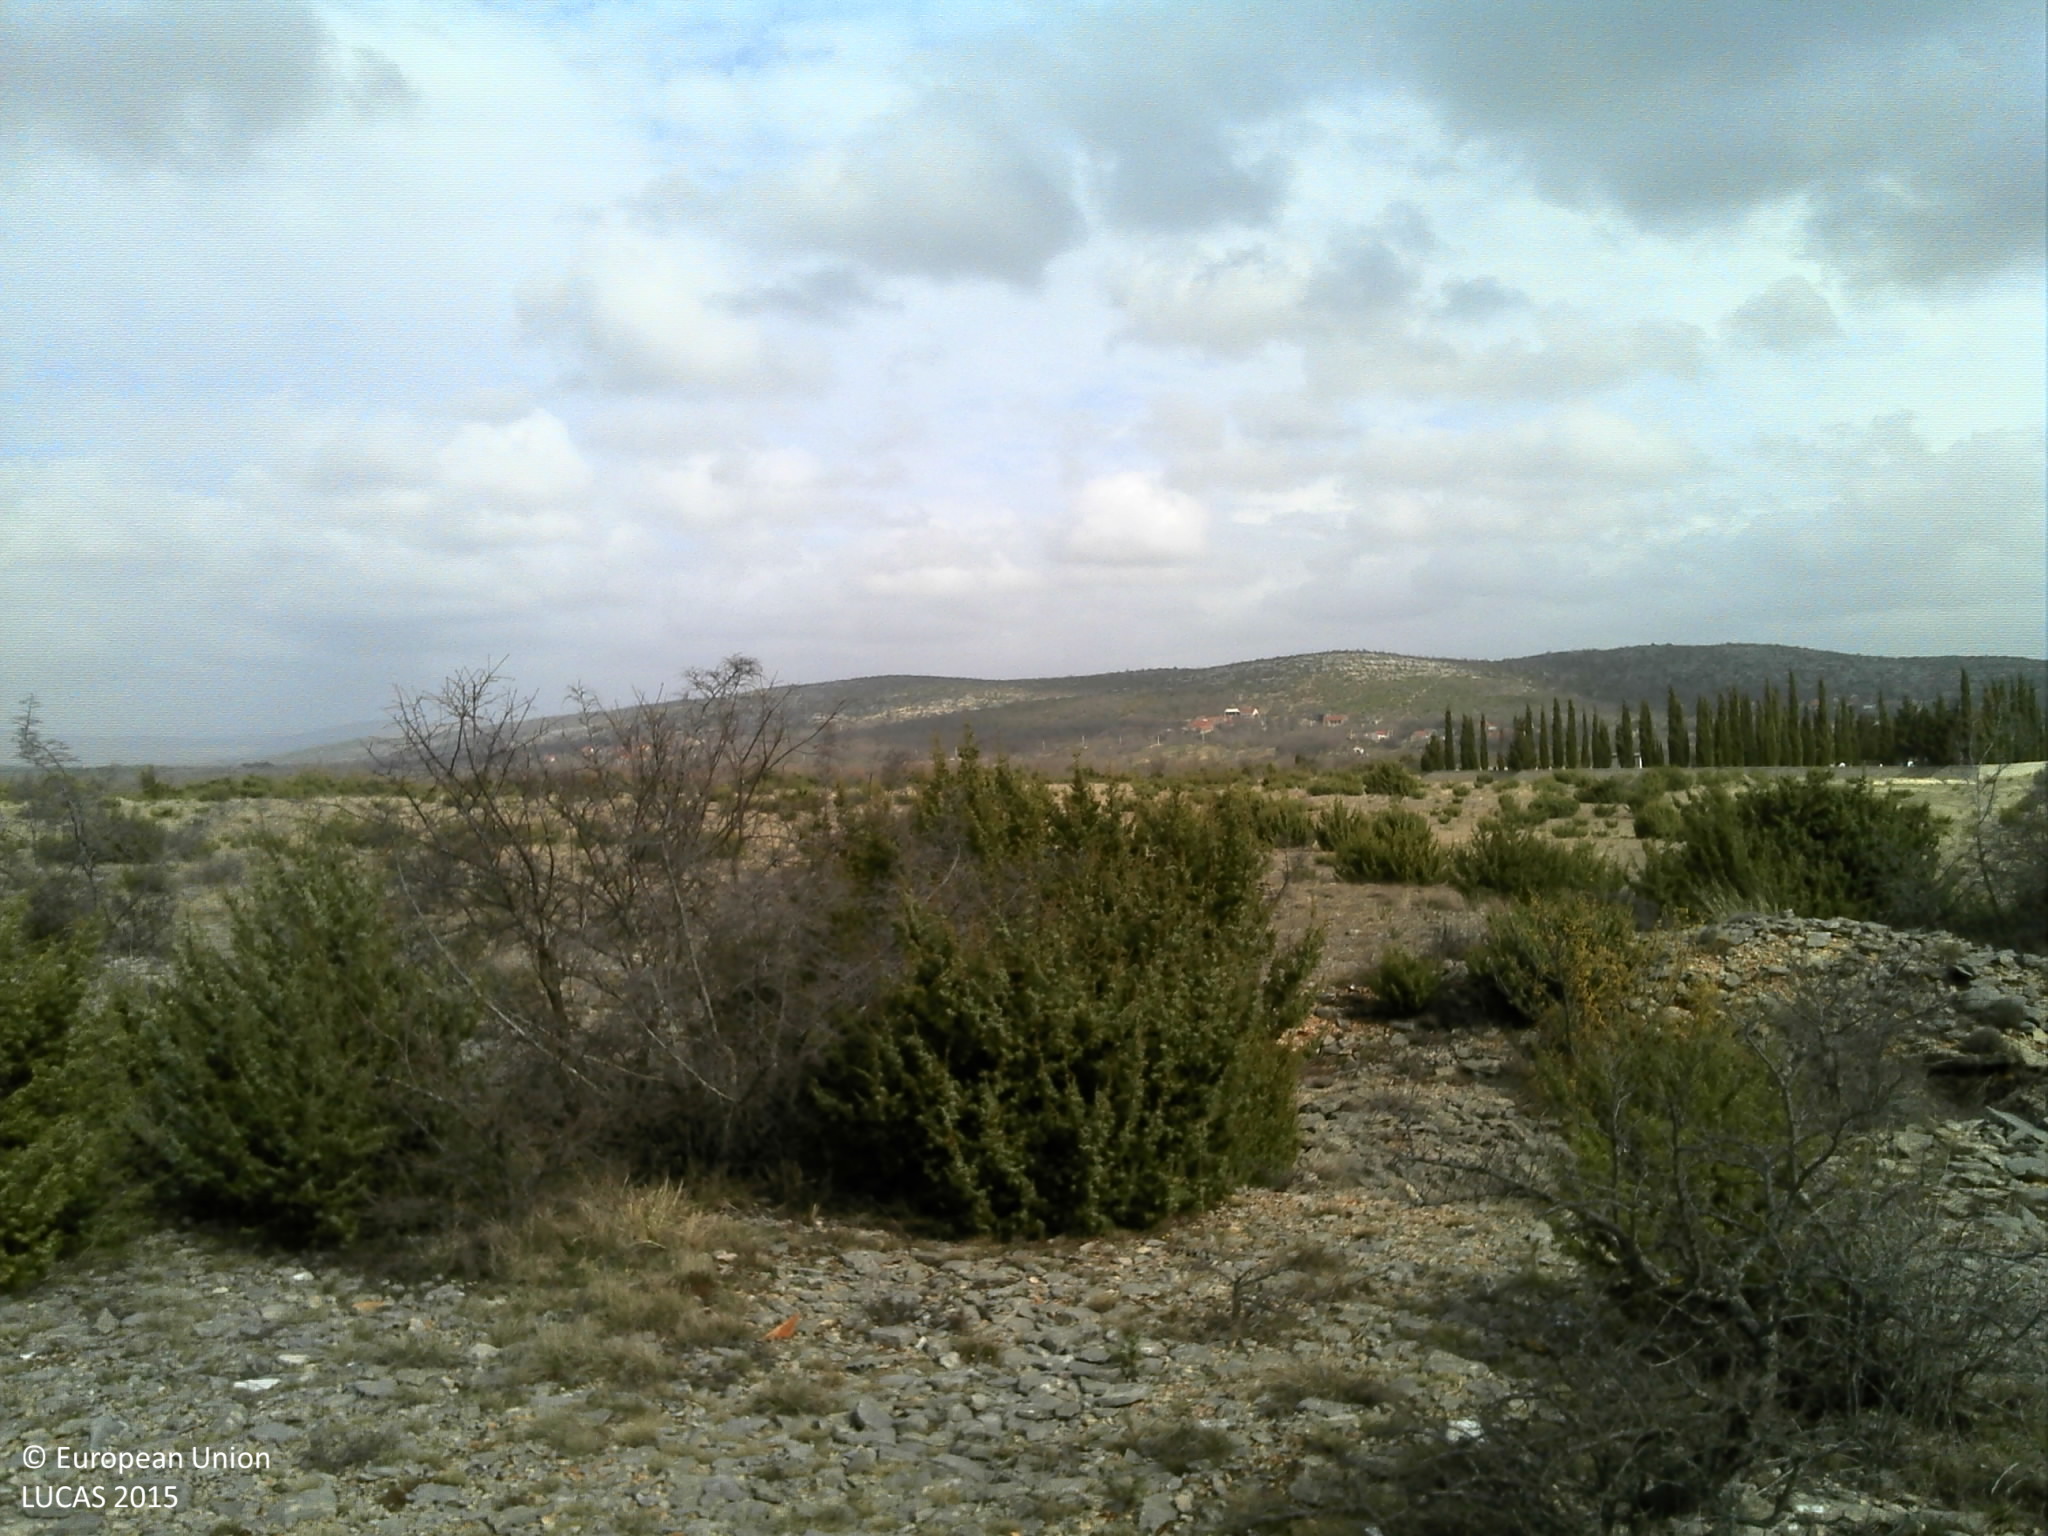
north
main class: Shrubland
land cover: Shrubland with sparse tree cover
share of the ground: 25 - 50 %
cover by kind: shrubs 30 %, unconsolidated bare surface 30 %, consolidated bare surface 10 %, broadleaved forest trees 5 %
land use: Semi-natural and natural areas not in use
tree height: < 5 m
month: March
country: HR
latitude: 43.9678
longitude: 15.8625
